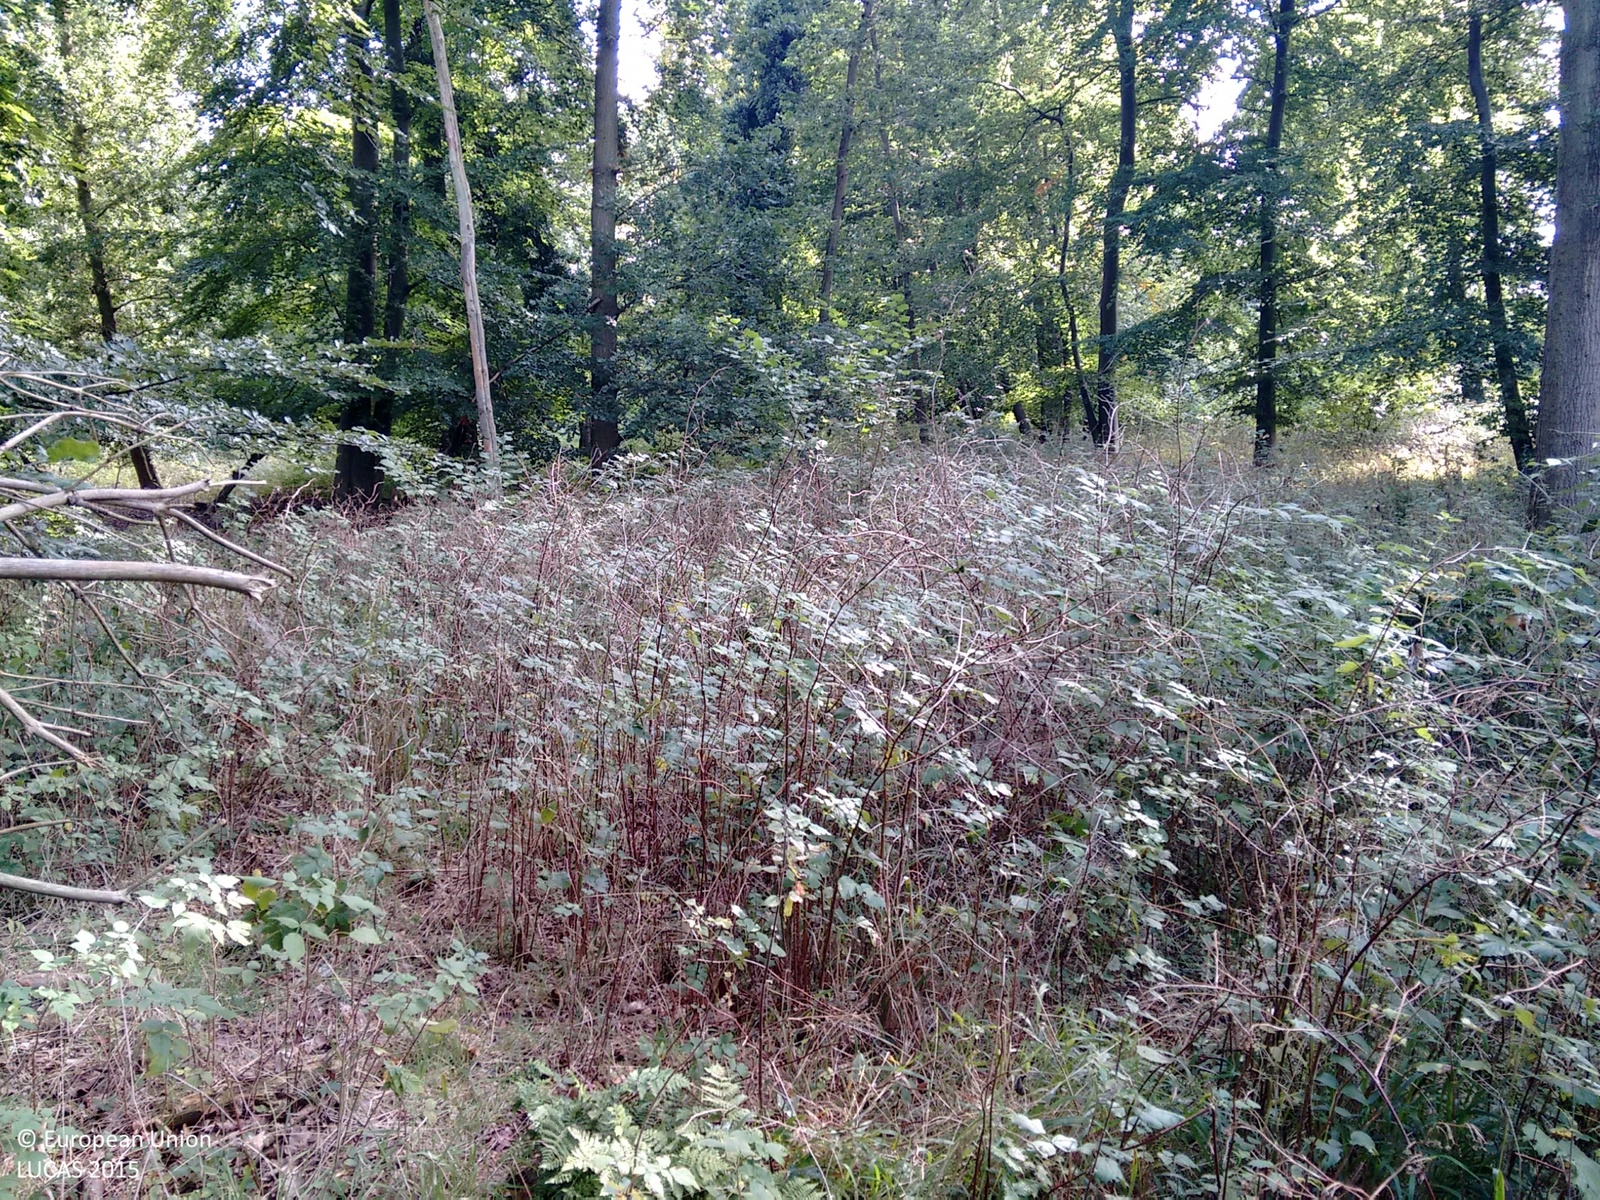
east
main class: Woodland
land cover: Broadleaved woodland
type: mesophytic deciduous forest
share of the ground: > 75 %
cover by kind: broadleaved forest trees 100 %
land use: Forestry
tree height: > 5 m
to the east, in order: Broadleaved woodland; Fences; Broadleaved woodland; Artificial constructions in urban areas
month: September
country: GB
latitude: 52.4256
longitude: 0.9025
